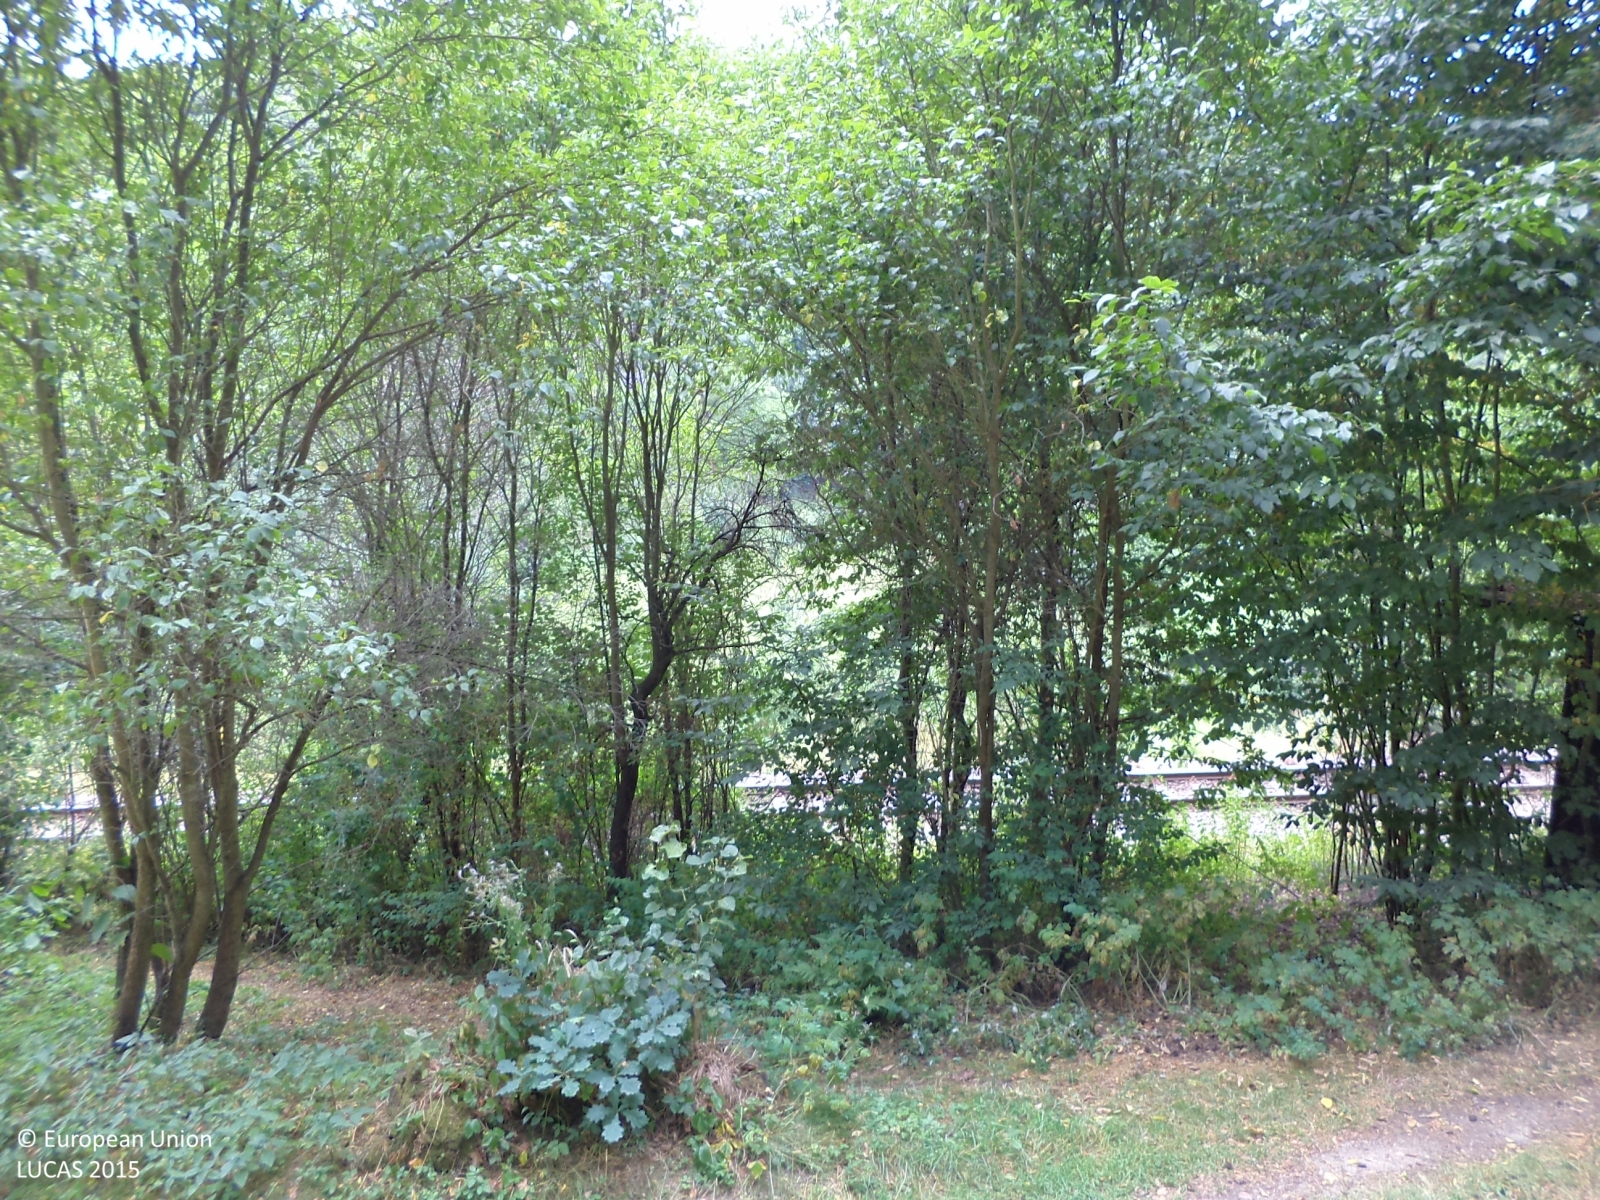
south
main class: Woodland
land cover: Broadleaved woodland
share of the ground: > 75 %
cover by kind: broadleaved forest trees 90 %, herbaceous plants 10 %
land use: Amenities, museums, leisure
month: July
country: CZ
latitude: 50.0069
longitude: 13.9775
